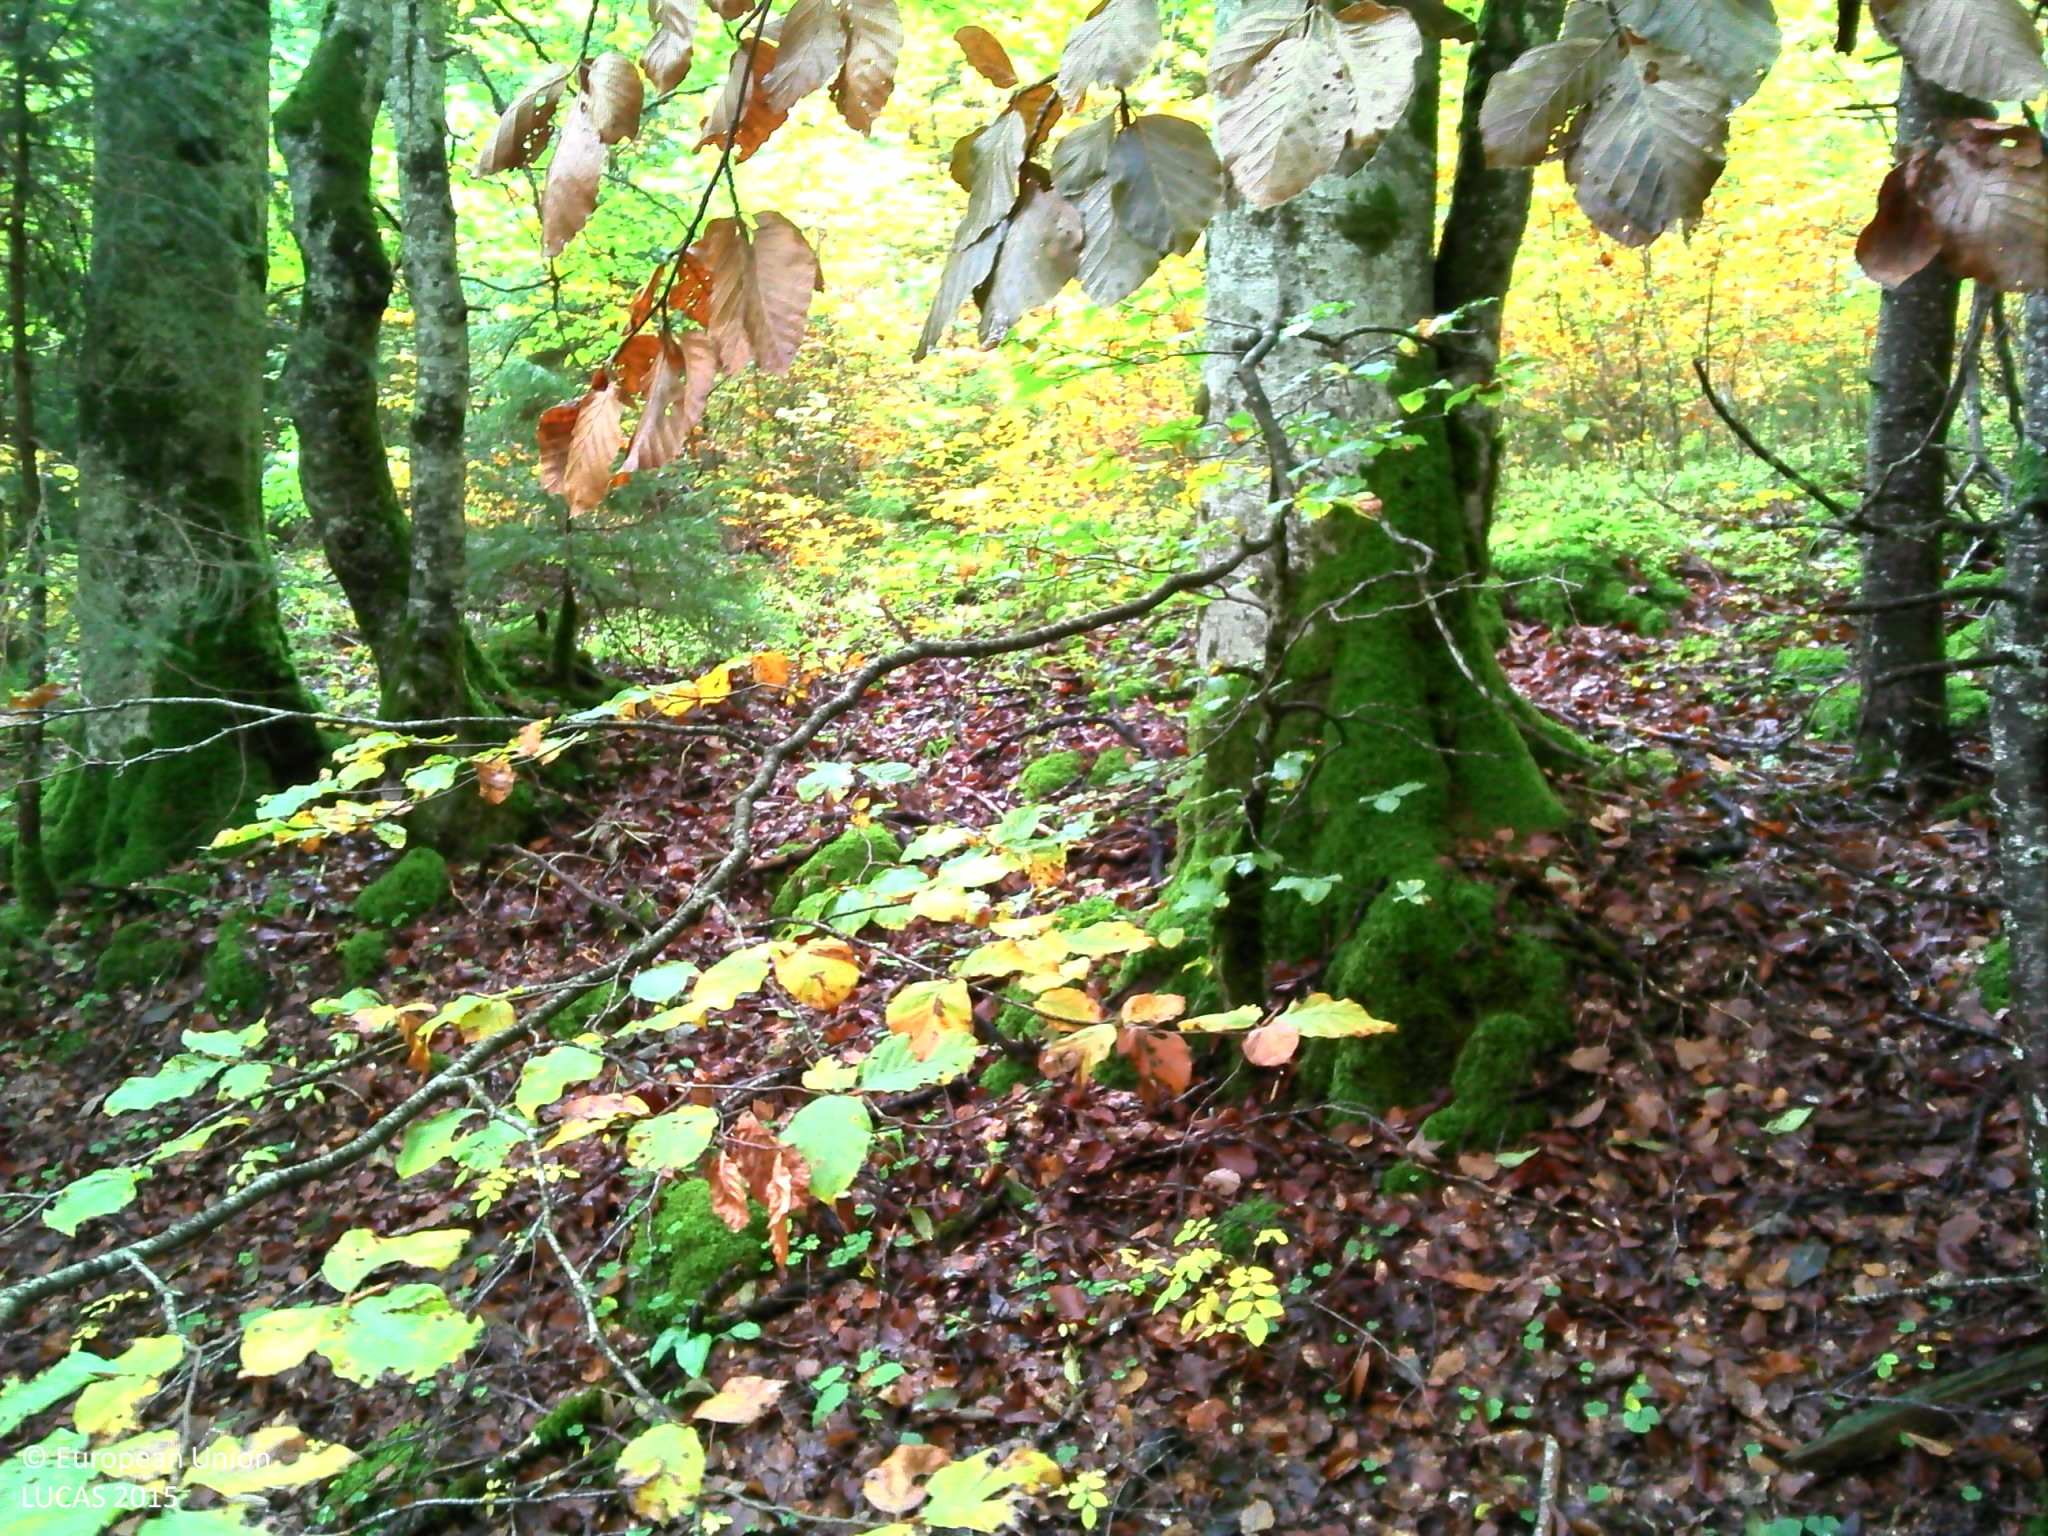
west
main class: Woodland
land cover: Spruce dominated mixed woodland
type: mountainous beech forest
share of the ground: 50 - 75 %
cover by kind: broadleaved forest trees 40 %, coniferous forest trees 30 %, unconsolidated bare surface 20 %, lichens and mosses 5 %, consolidated bare surface 5 %
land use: Forestry
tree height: > 5 m
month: October
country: FR
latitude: 46.7594
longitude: 6.4022
